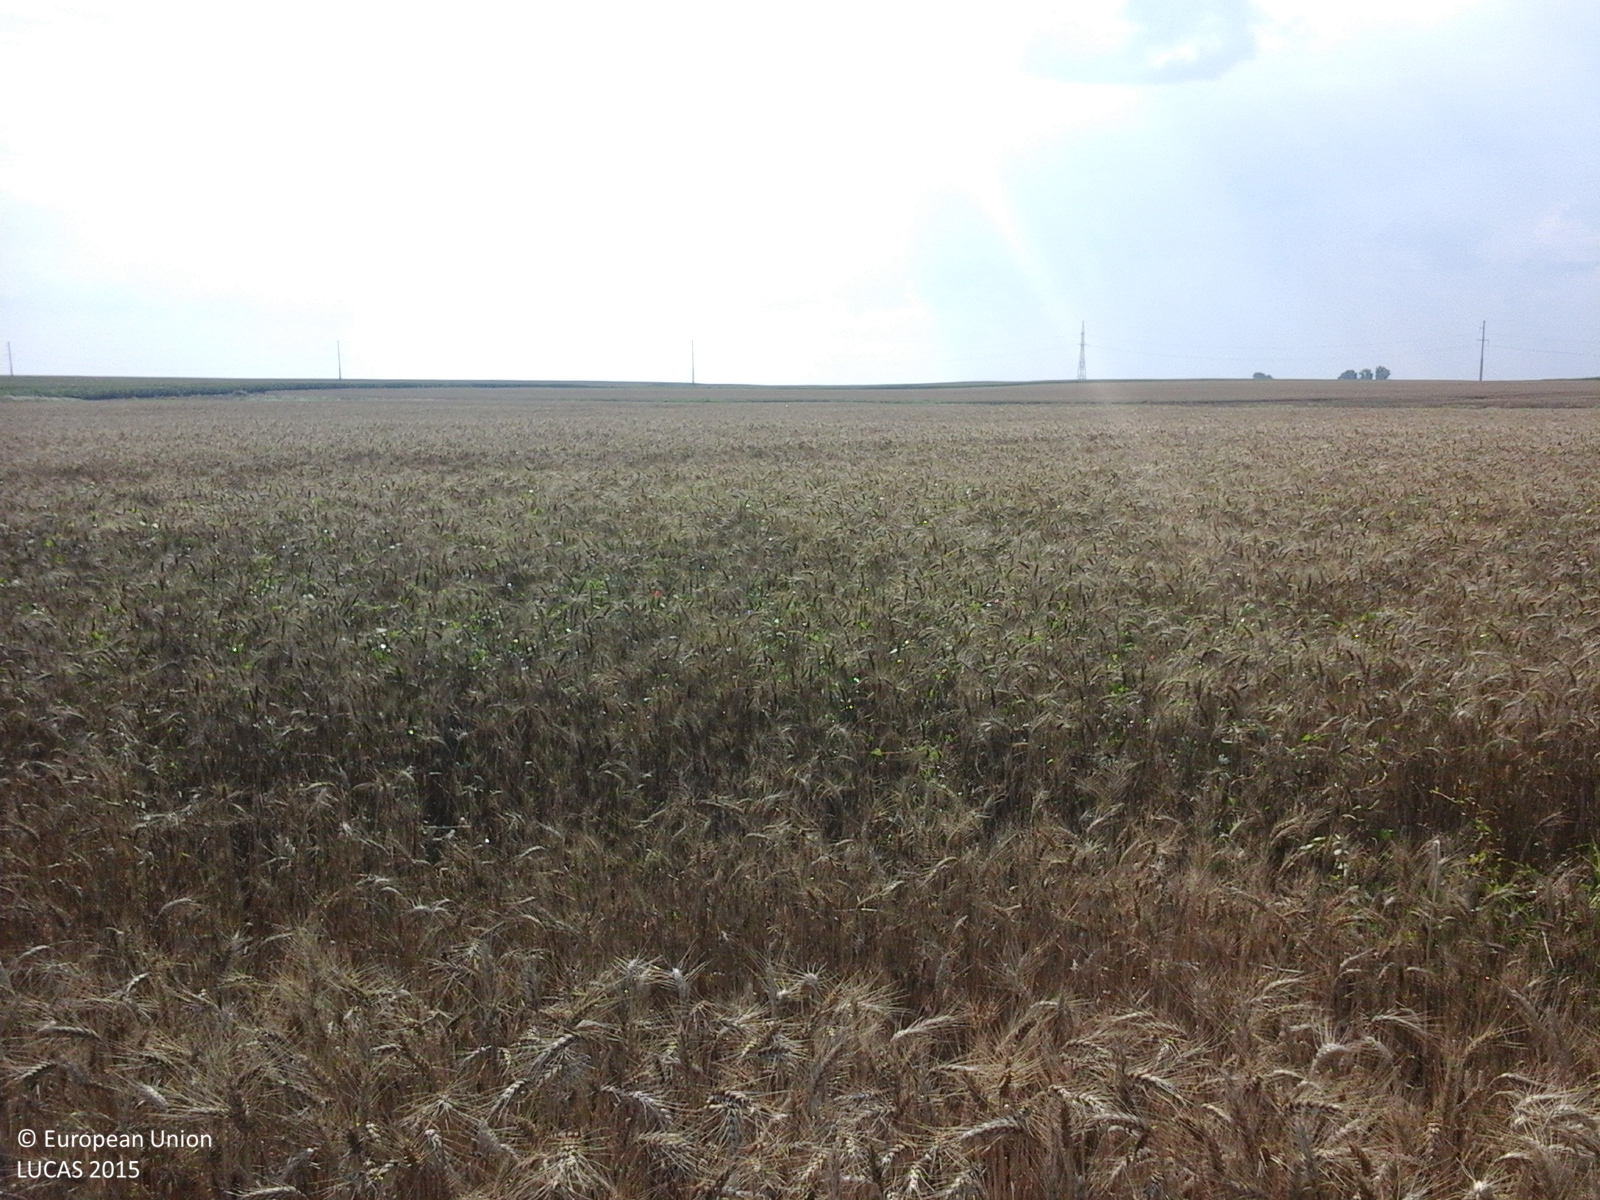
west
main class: Cropland
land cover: Common wheat
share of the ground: > 75 %
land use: Agriculture (excluding fallow land and kitchen gardens)
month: July
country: RO
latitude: 43.8425
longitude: 25.8266
